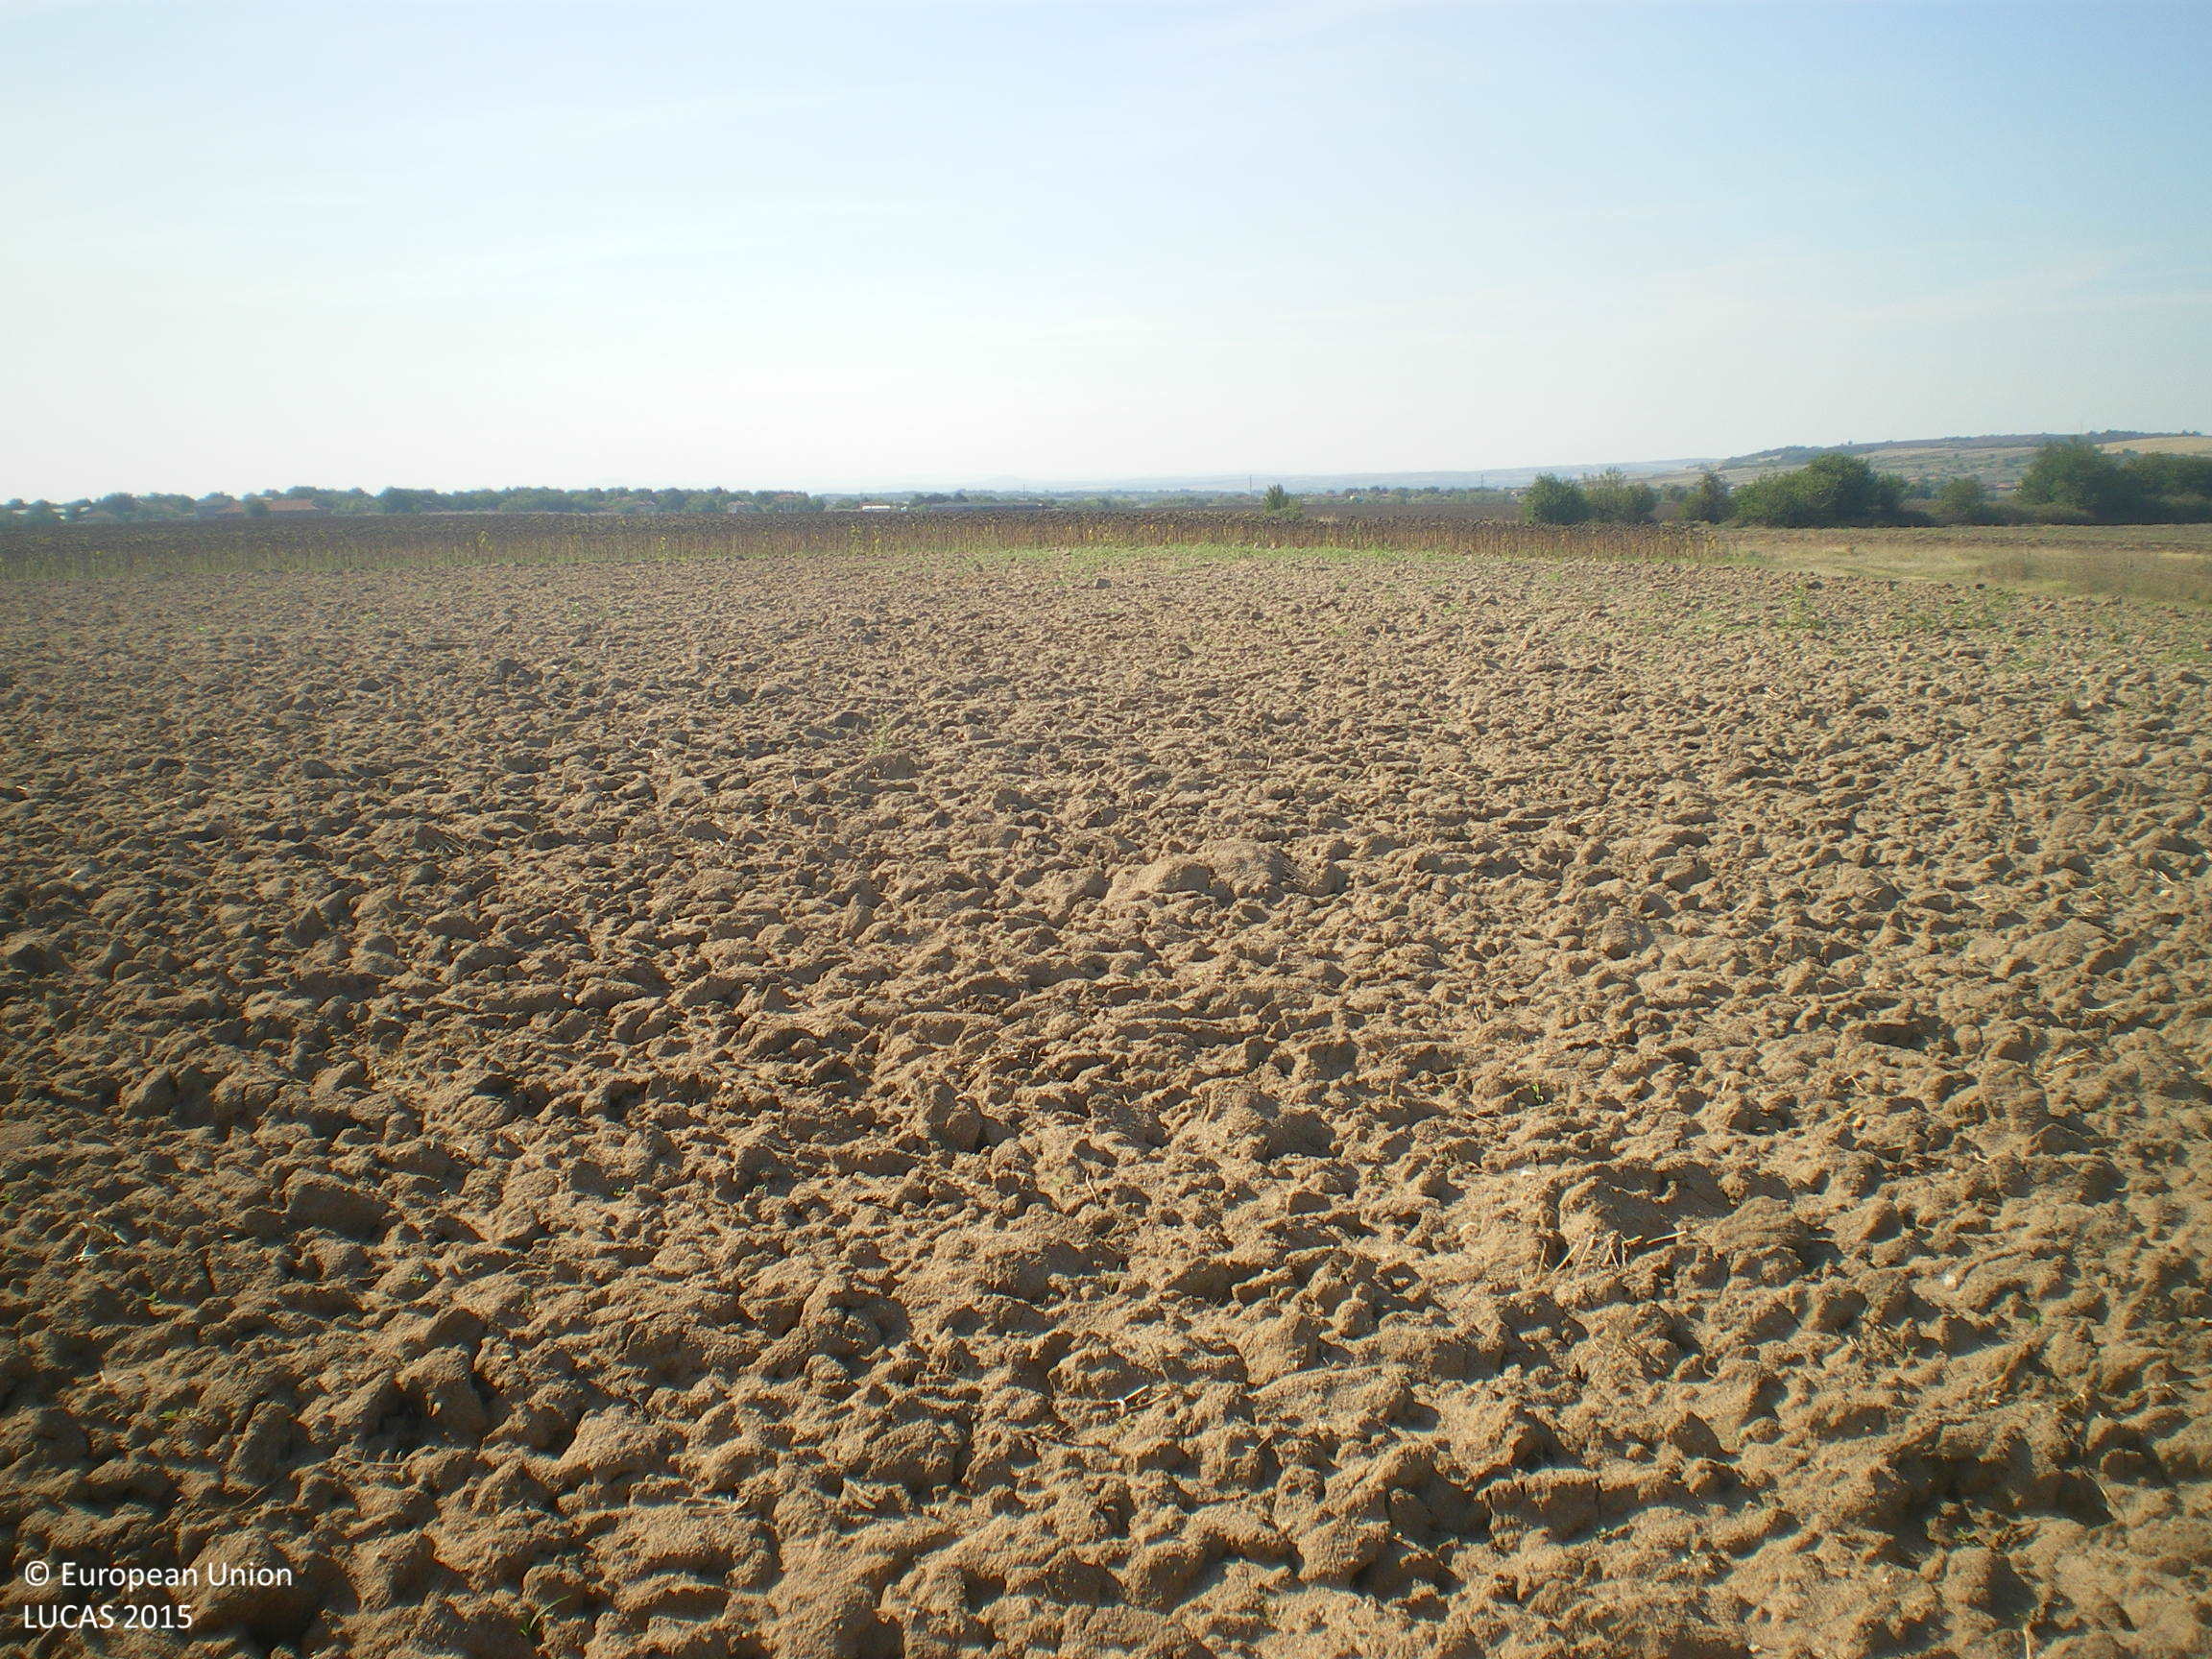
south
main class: Cropland
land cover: Common wheat
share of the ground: < 10 %
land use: Agriculture (excluding fallow land and kitchen gardens)
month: September
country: BG
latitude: 42.1085
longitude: 25.8792
